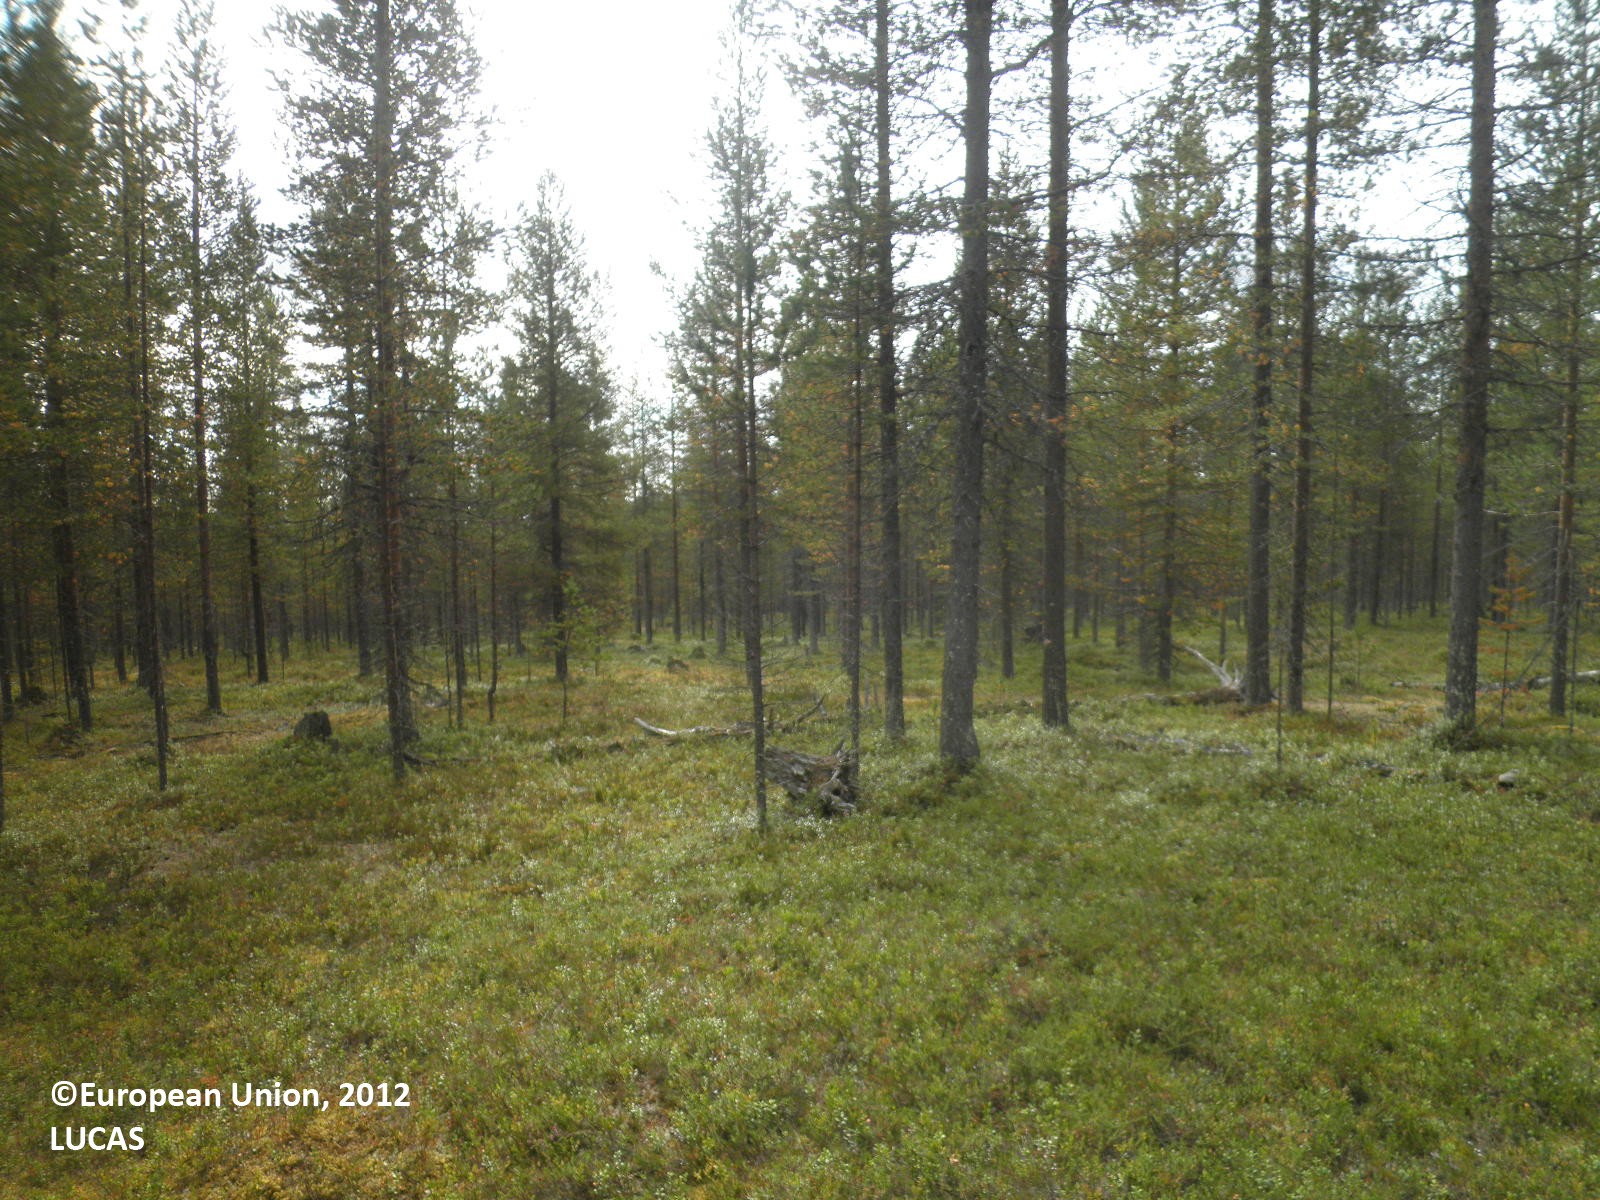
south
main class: Woodland
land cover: Pine dominated coniferous woodland
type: boreal forest
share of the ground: 50 - 75 %
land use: Forestry
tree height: > 5 m
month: August
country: FI
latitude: 67.7451
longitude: 28.9006
